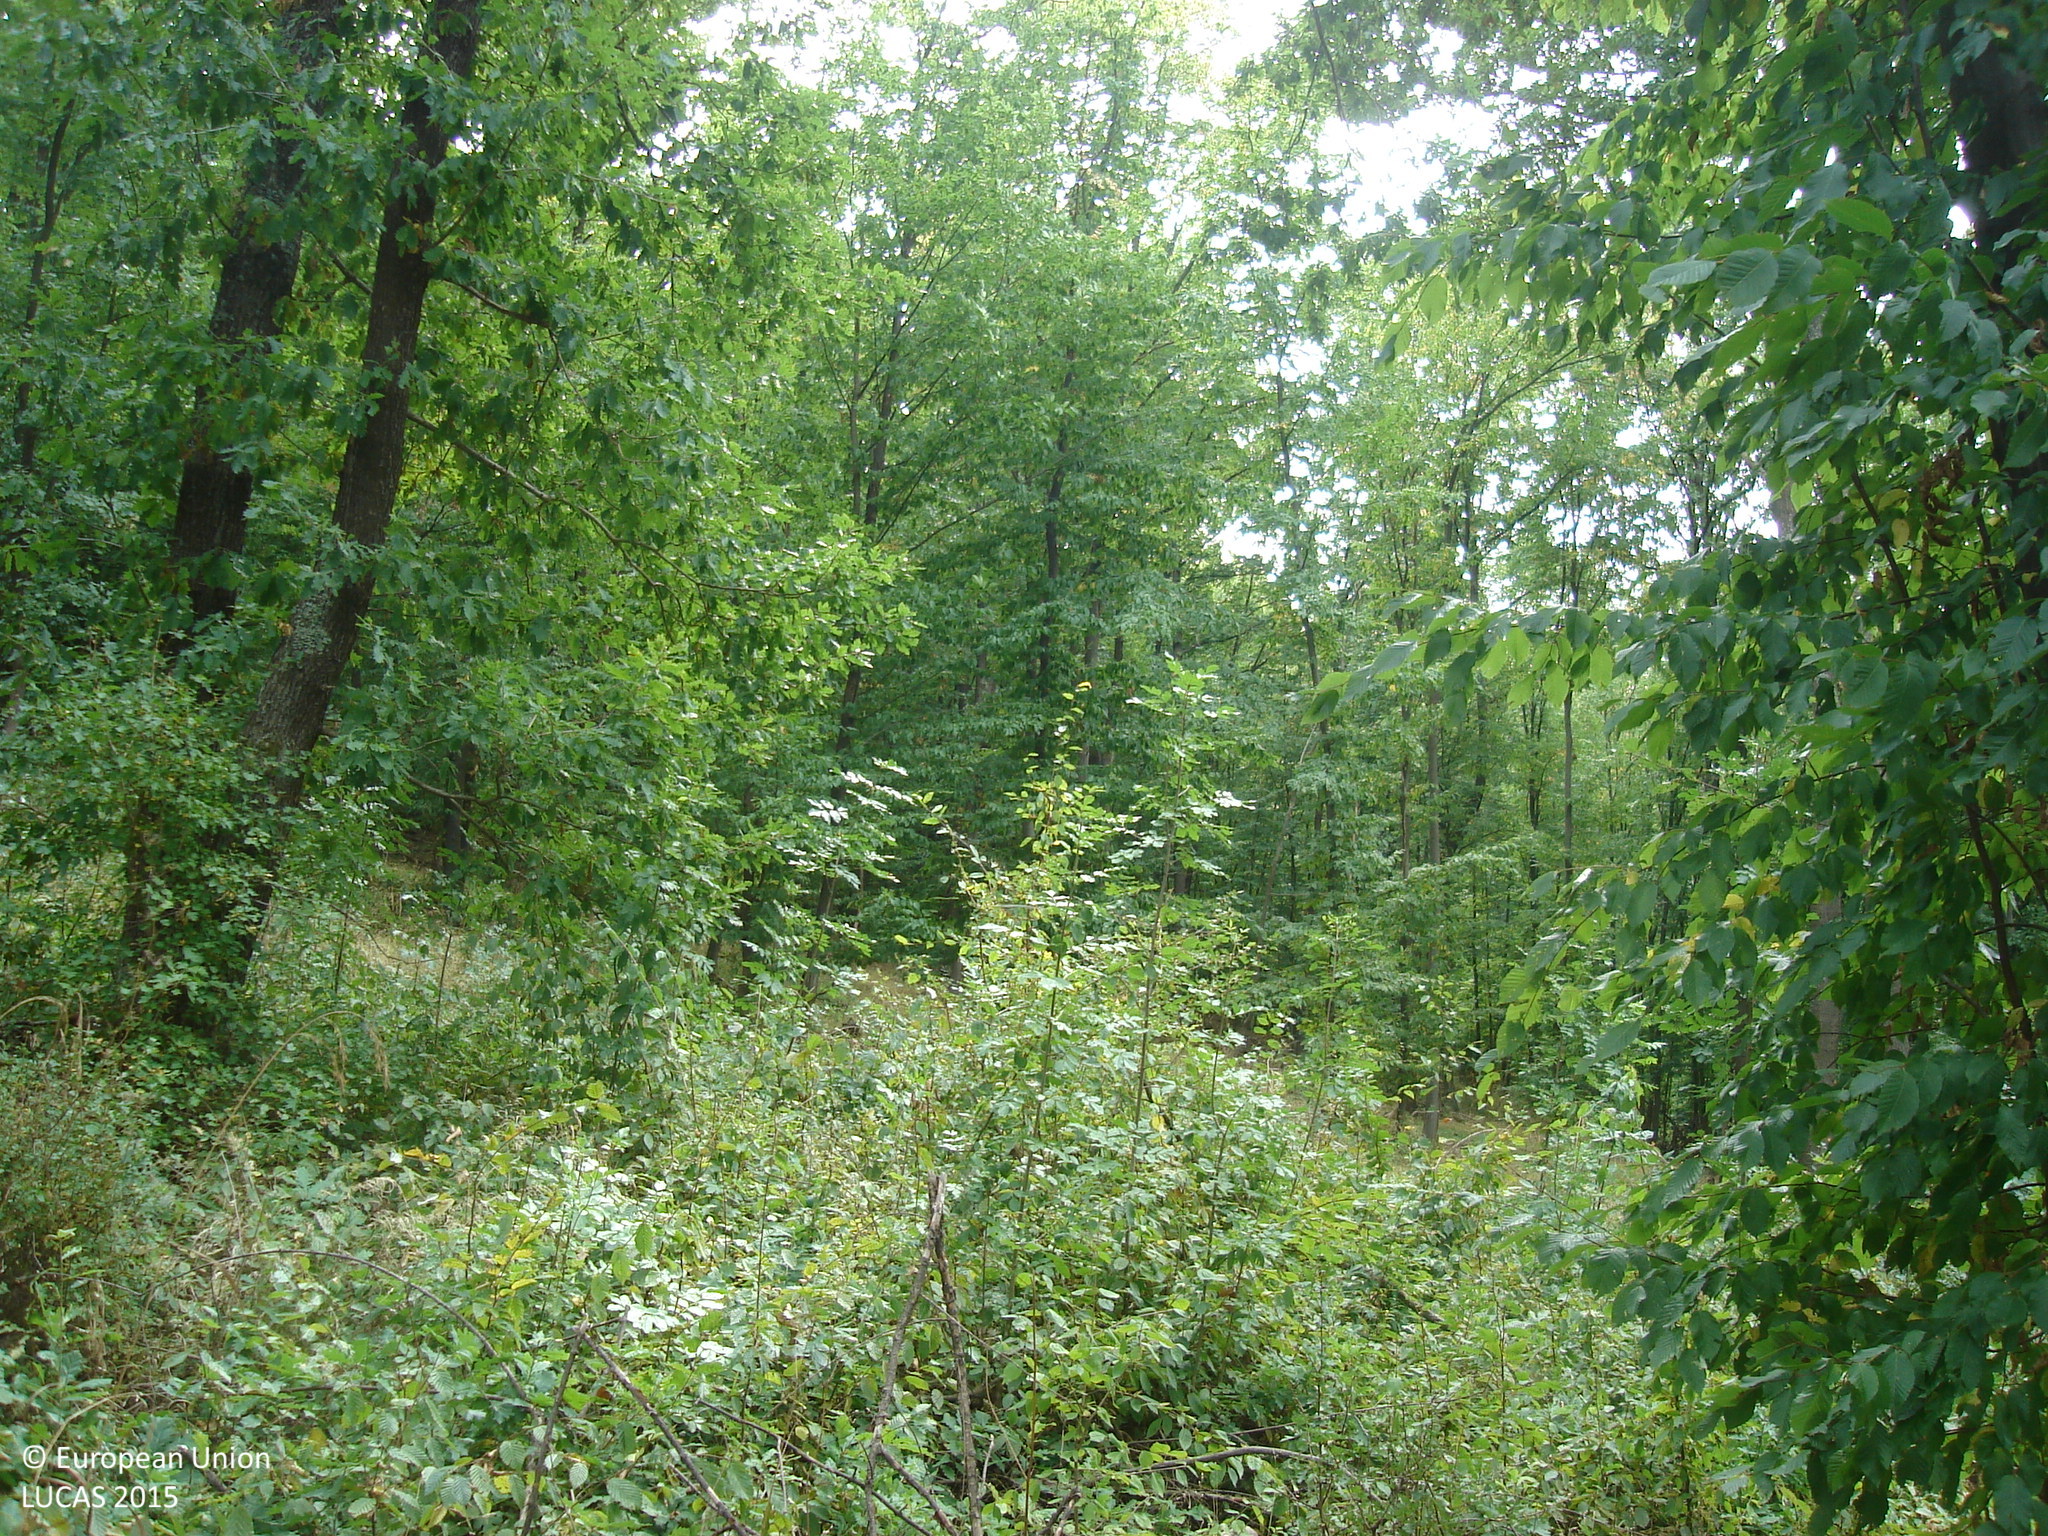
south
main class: Woodland
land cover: Broadleaved woodland
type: acidophilous oak and oak-birch forest
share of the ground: 50 - 75 %
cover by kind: broadleaved forest trees 60 %, shrubs 20 %, herbaceous plants 20 %
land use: Forestry
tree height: > 5 m
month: September
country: BG
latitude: 42.6438
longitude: 23.8853
